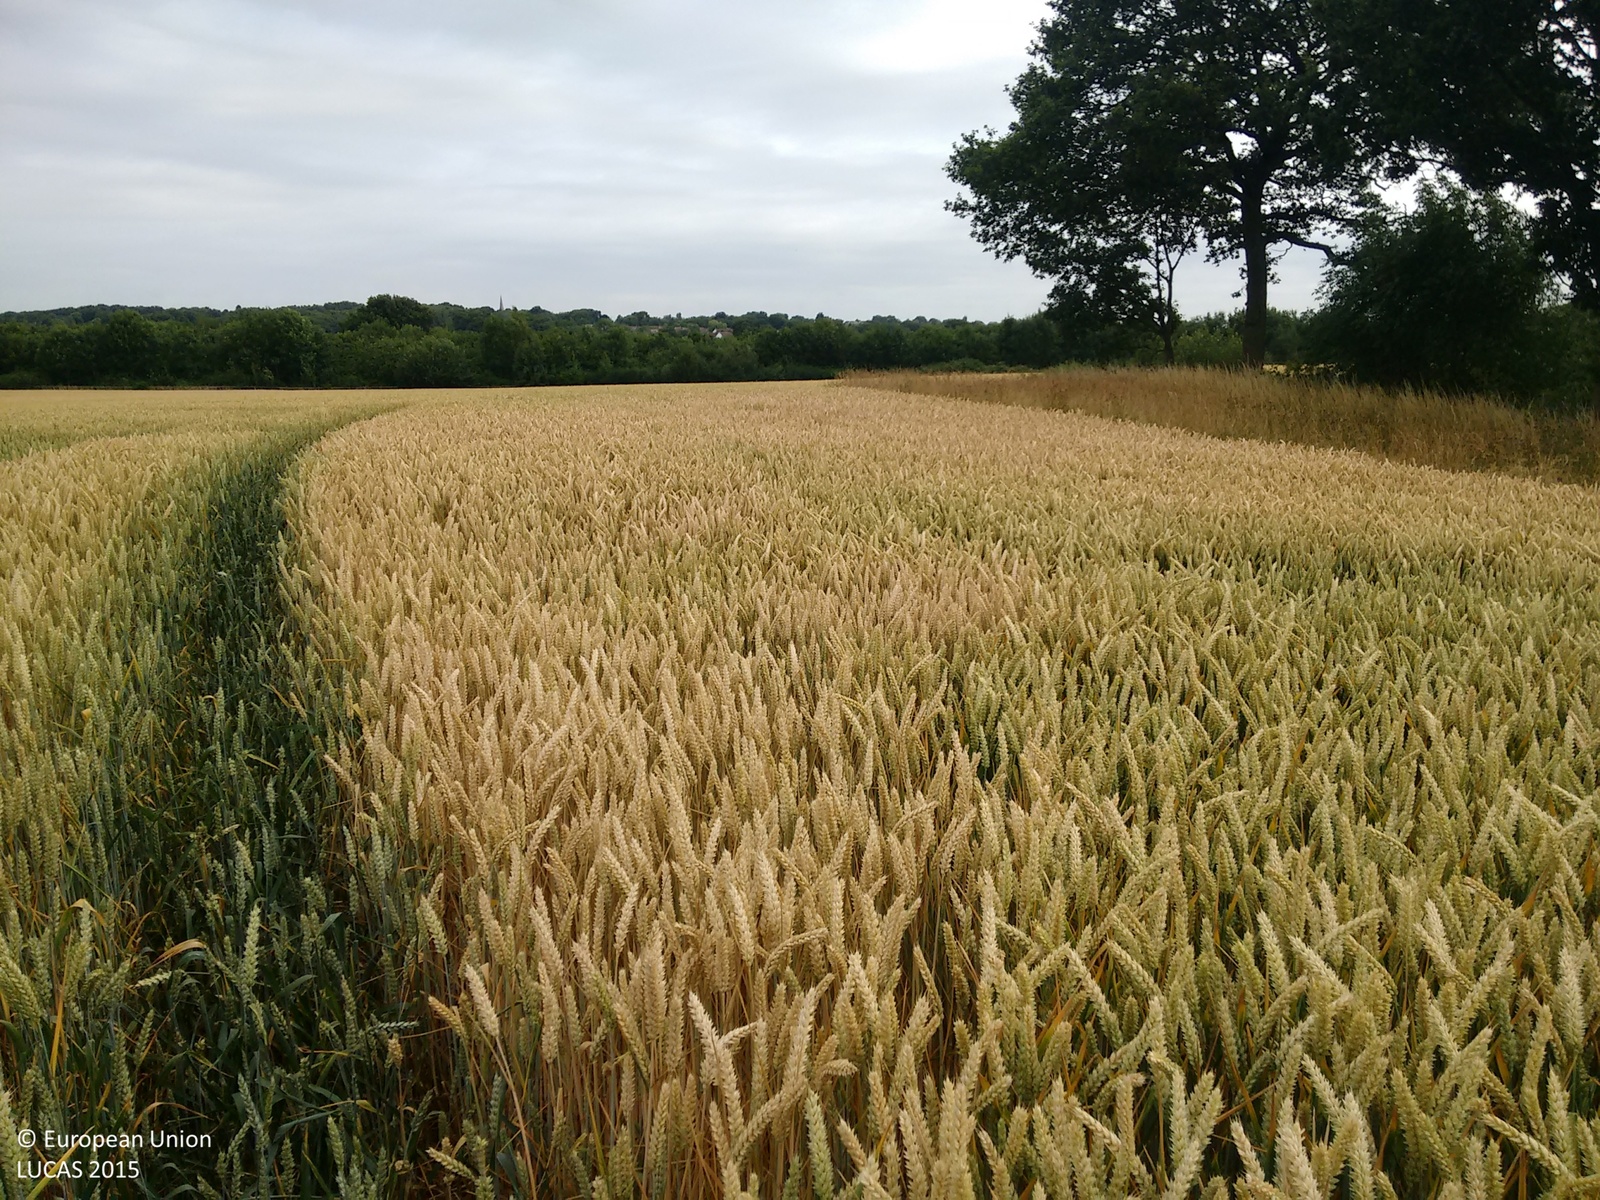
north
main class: Cropland
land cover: Common wheat
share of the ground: > 75 %
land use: Agriculture (excluding fallow land and kitchen gardens)
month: July
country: GB
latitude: 51.6854
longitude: 0.4687
